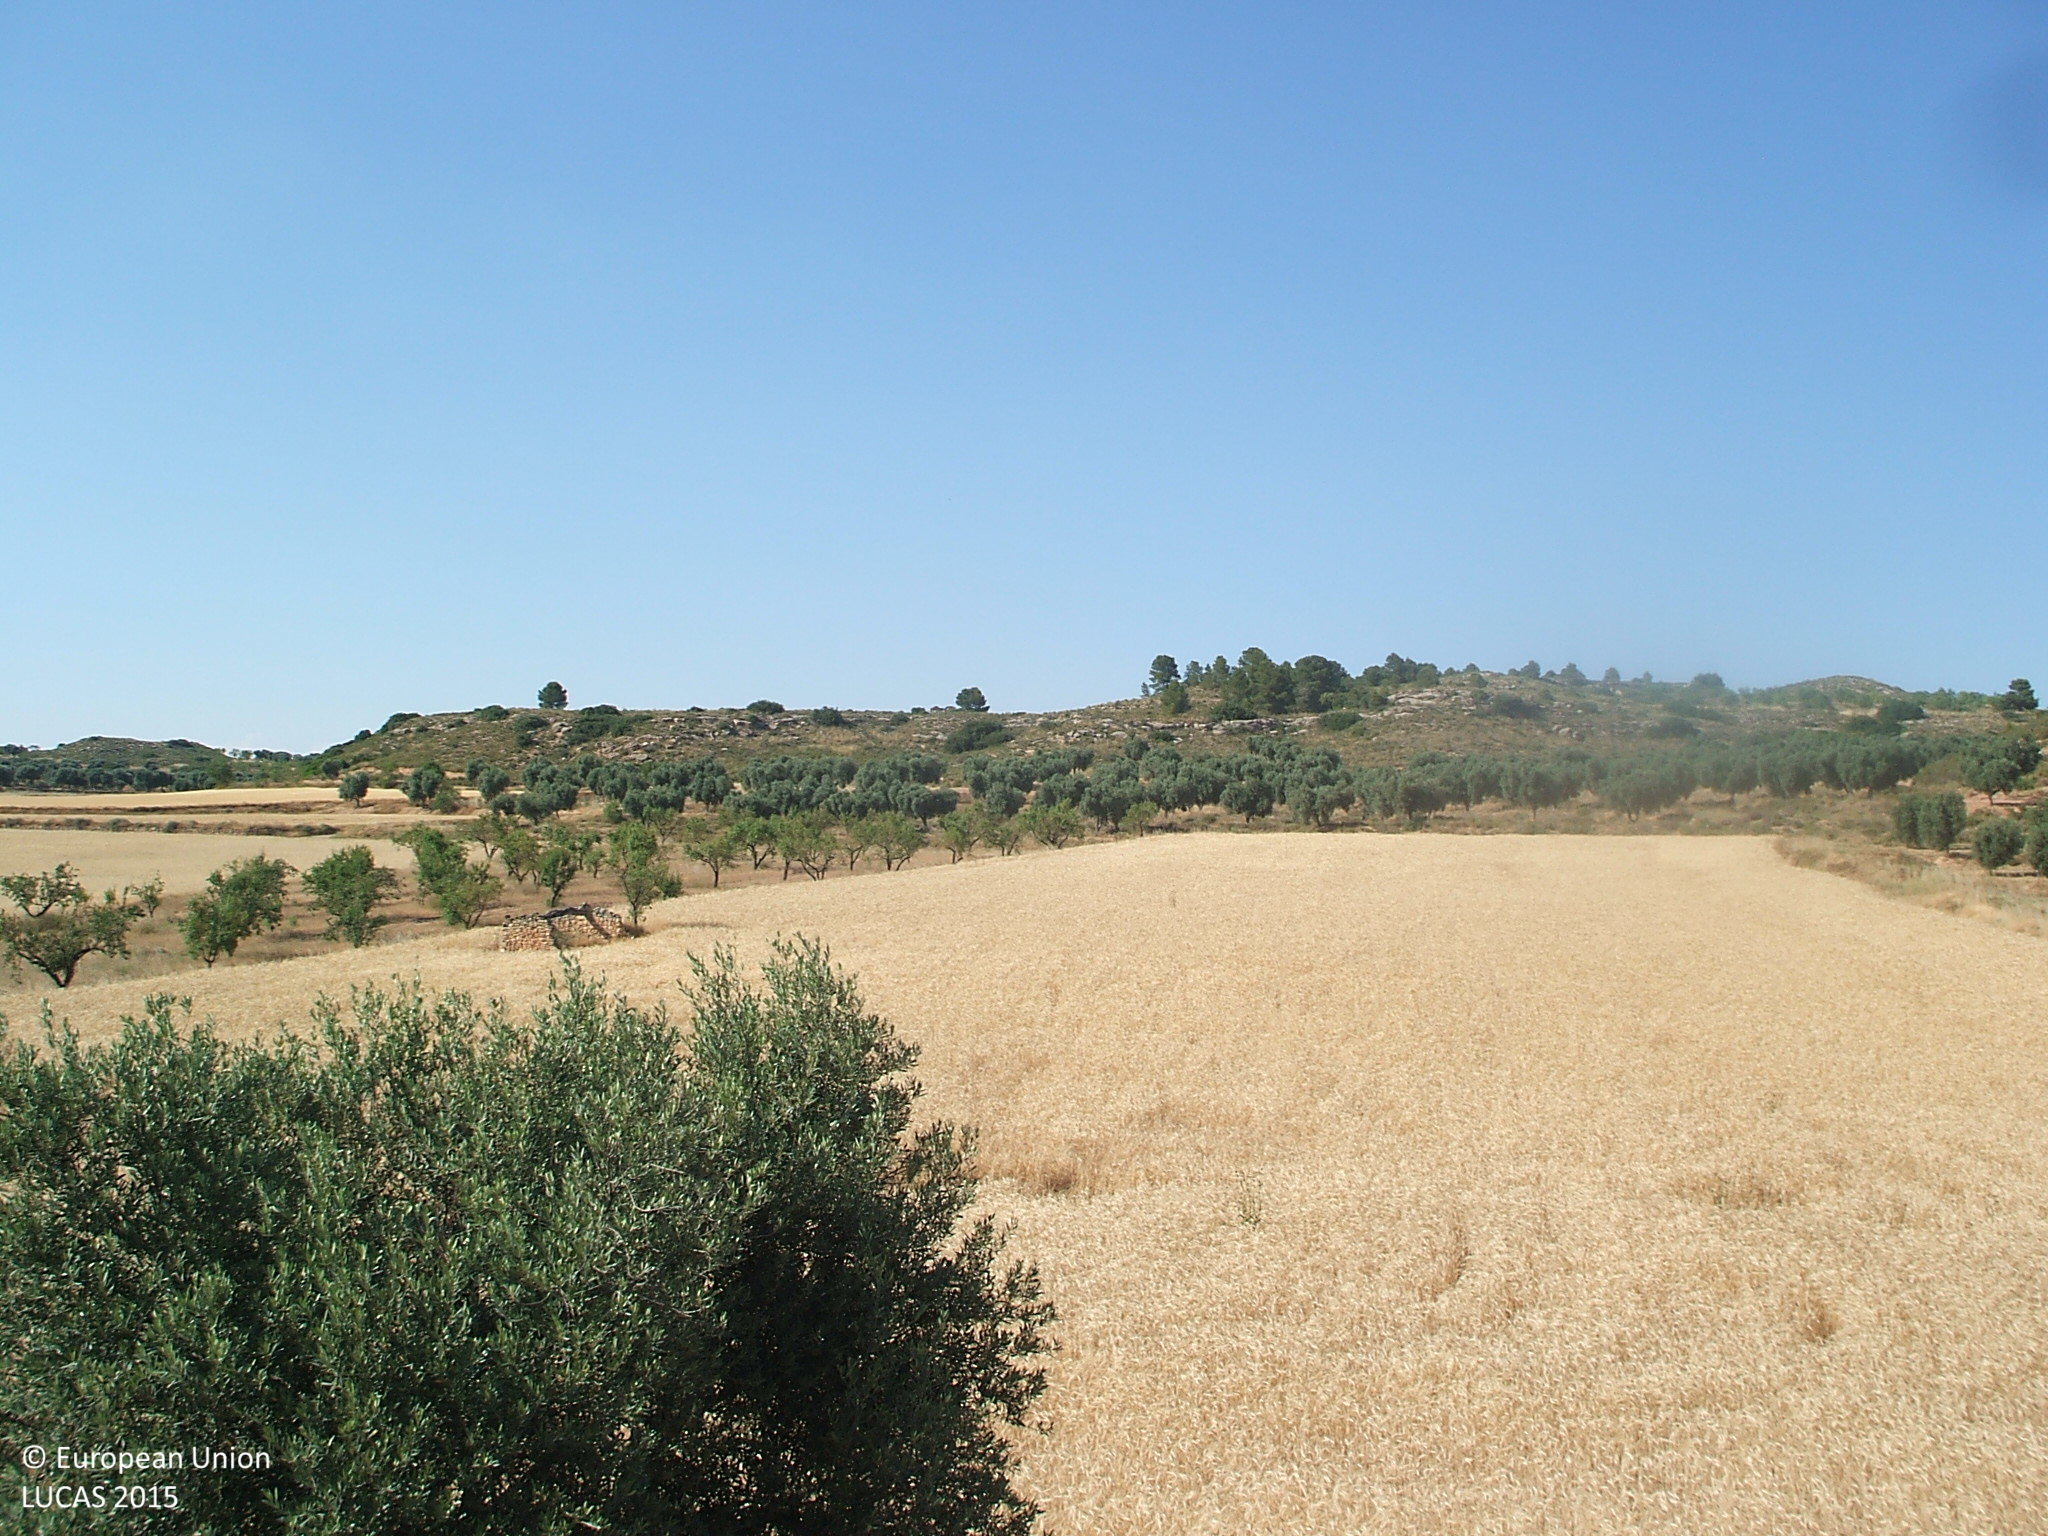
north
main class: Cropland
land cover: Vineyards
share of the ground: 10 - 25 %
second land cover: Other bare soil
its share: > 75 %
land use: Agriculture (excluding fallow land and kitchen gardens)
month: June
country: ES
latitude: 40.9808
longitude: -0.1249
